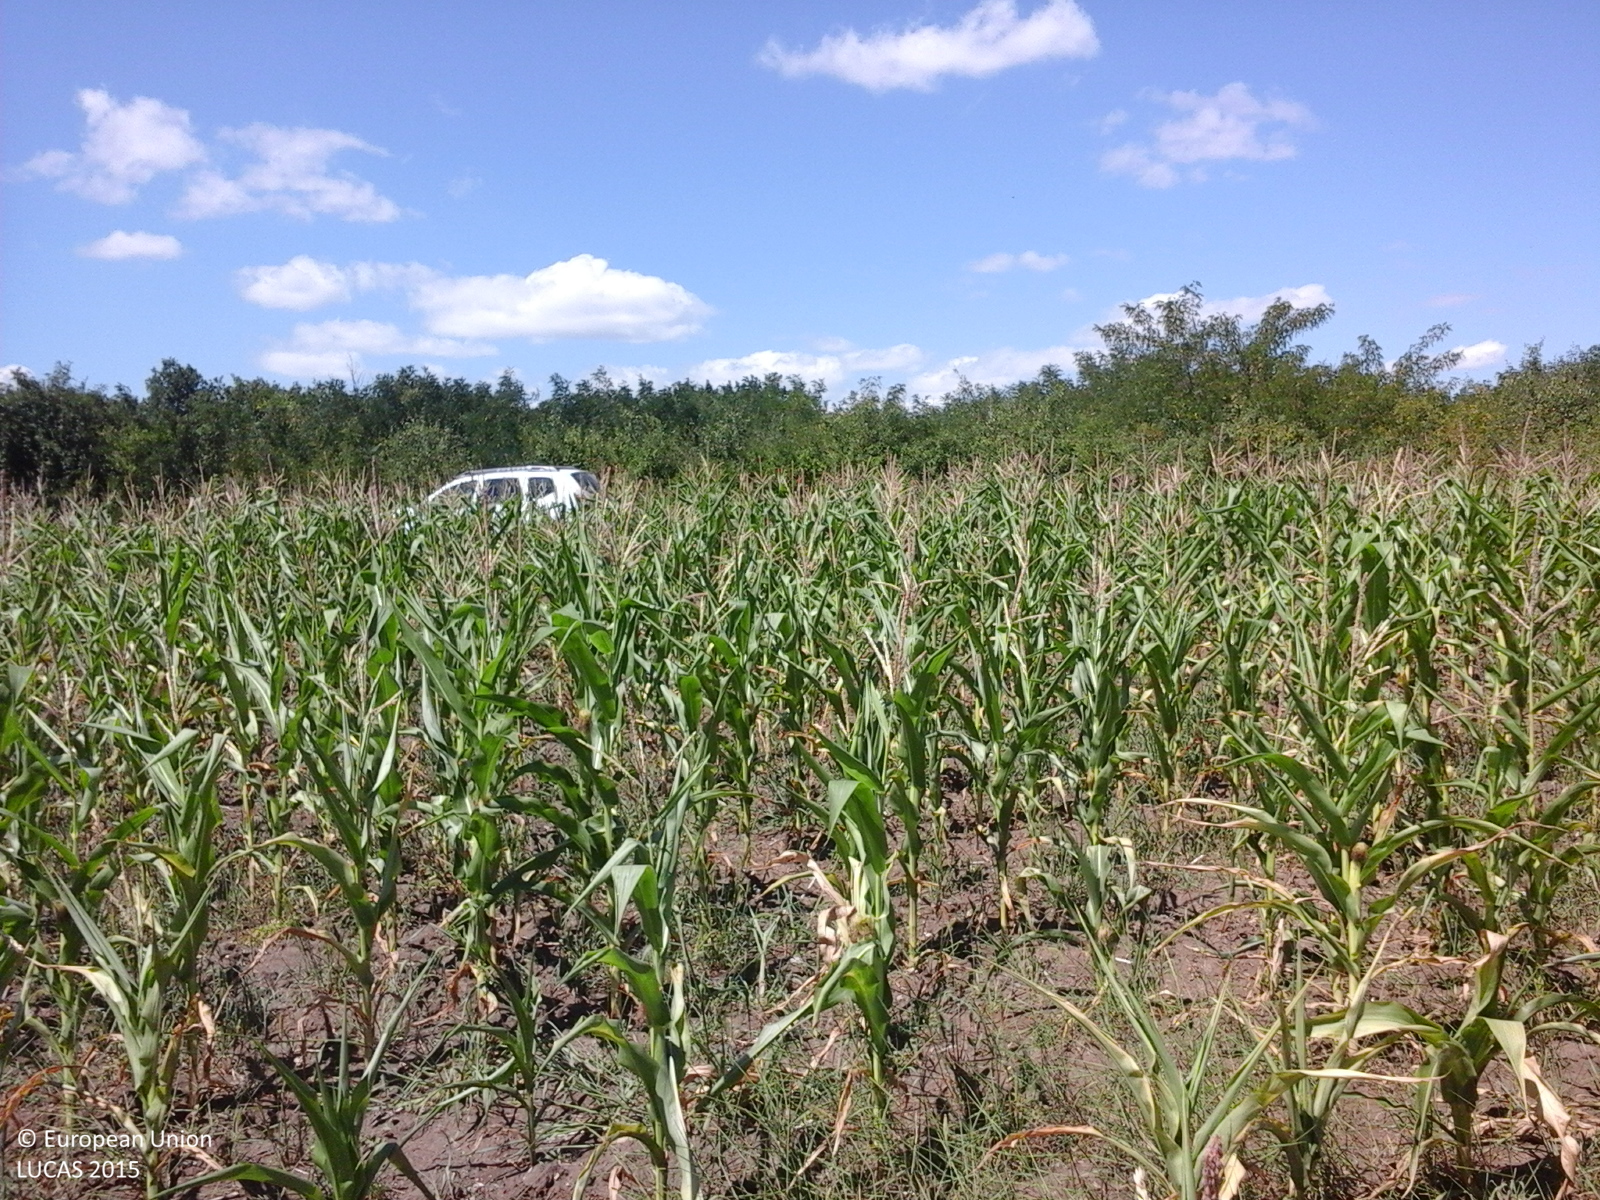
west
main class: Cropland
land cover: Maize
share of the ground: > 75 %
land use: Agriculture (excluding fallow land and kitchen gardens)
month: July
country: RO
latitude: 45.9433
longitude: 27.7204
